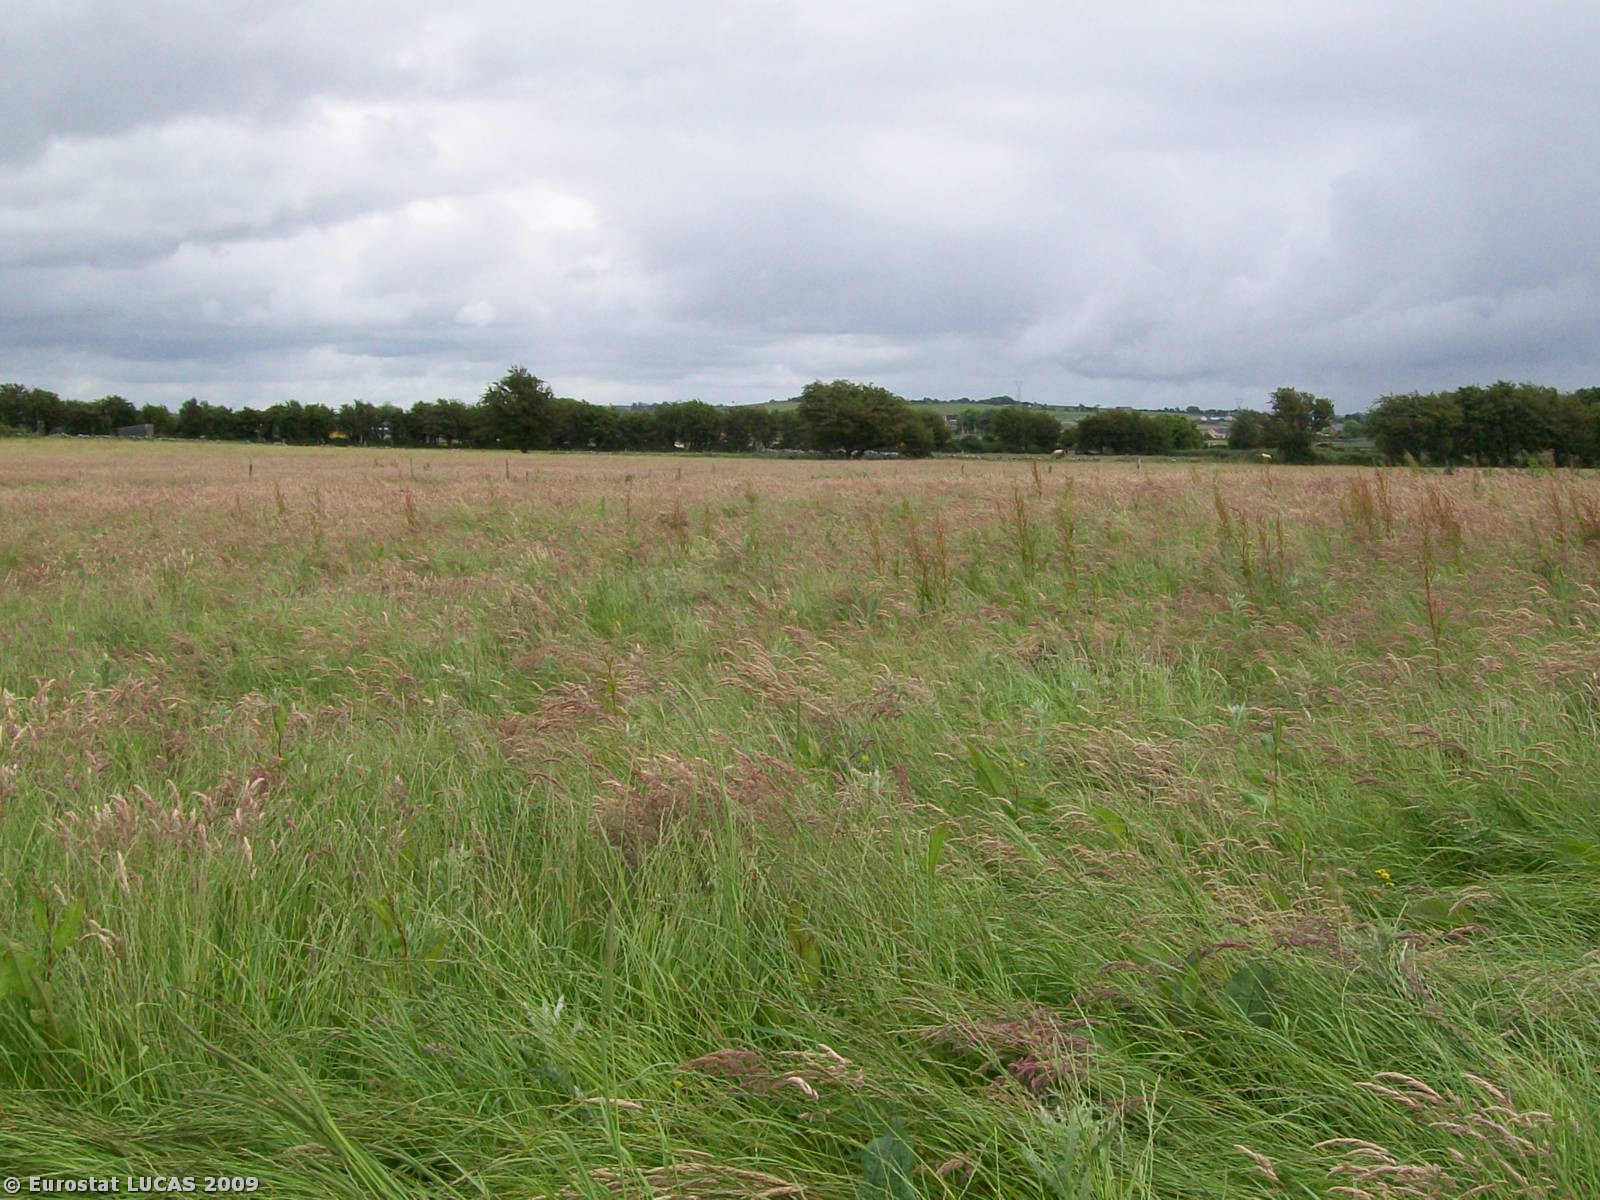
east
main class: Grassland
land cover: Grassland without tree/shrub cover
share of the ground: > 75 %
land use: Agriculture (excluding fallow land and kitchen gardens)
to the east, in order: Grassland without tree/shrub cover; Fences; Grassland without tree/shrub cover; Dry stone walls; Grassland without tree/shrub cover
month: June
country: IE
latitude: 53.3838
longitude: -8.8336
